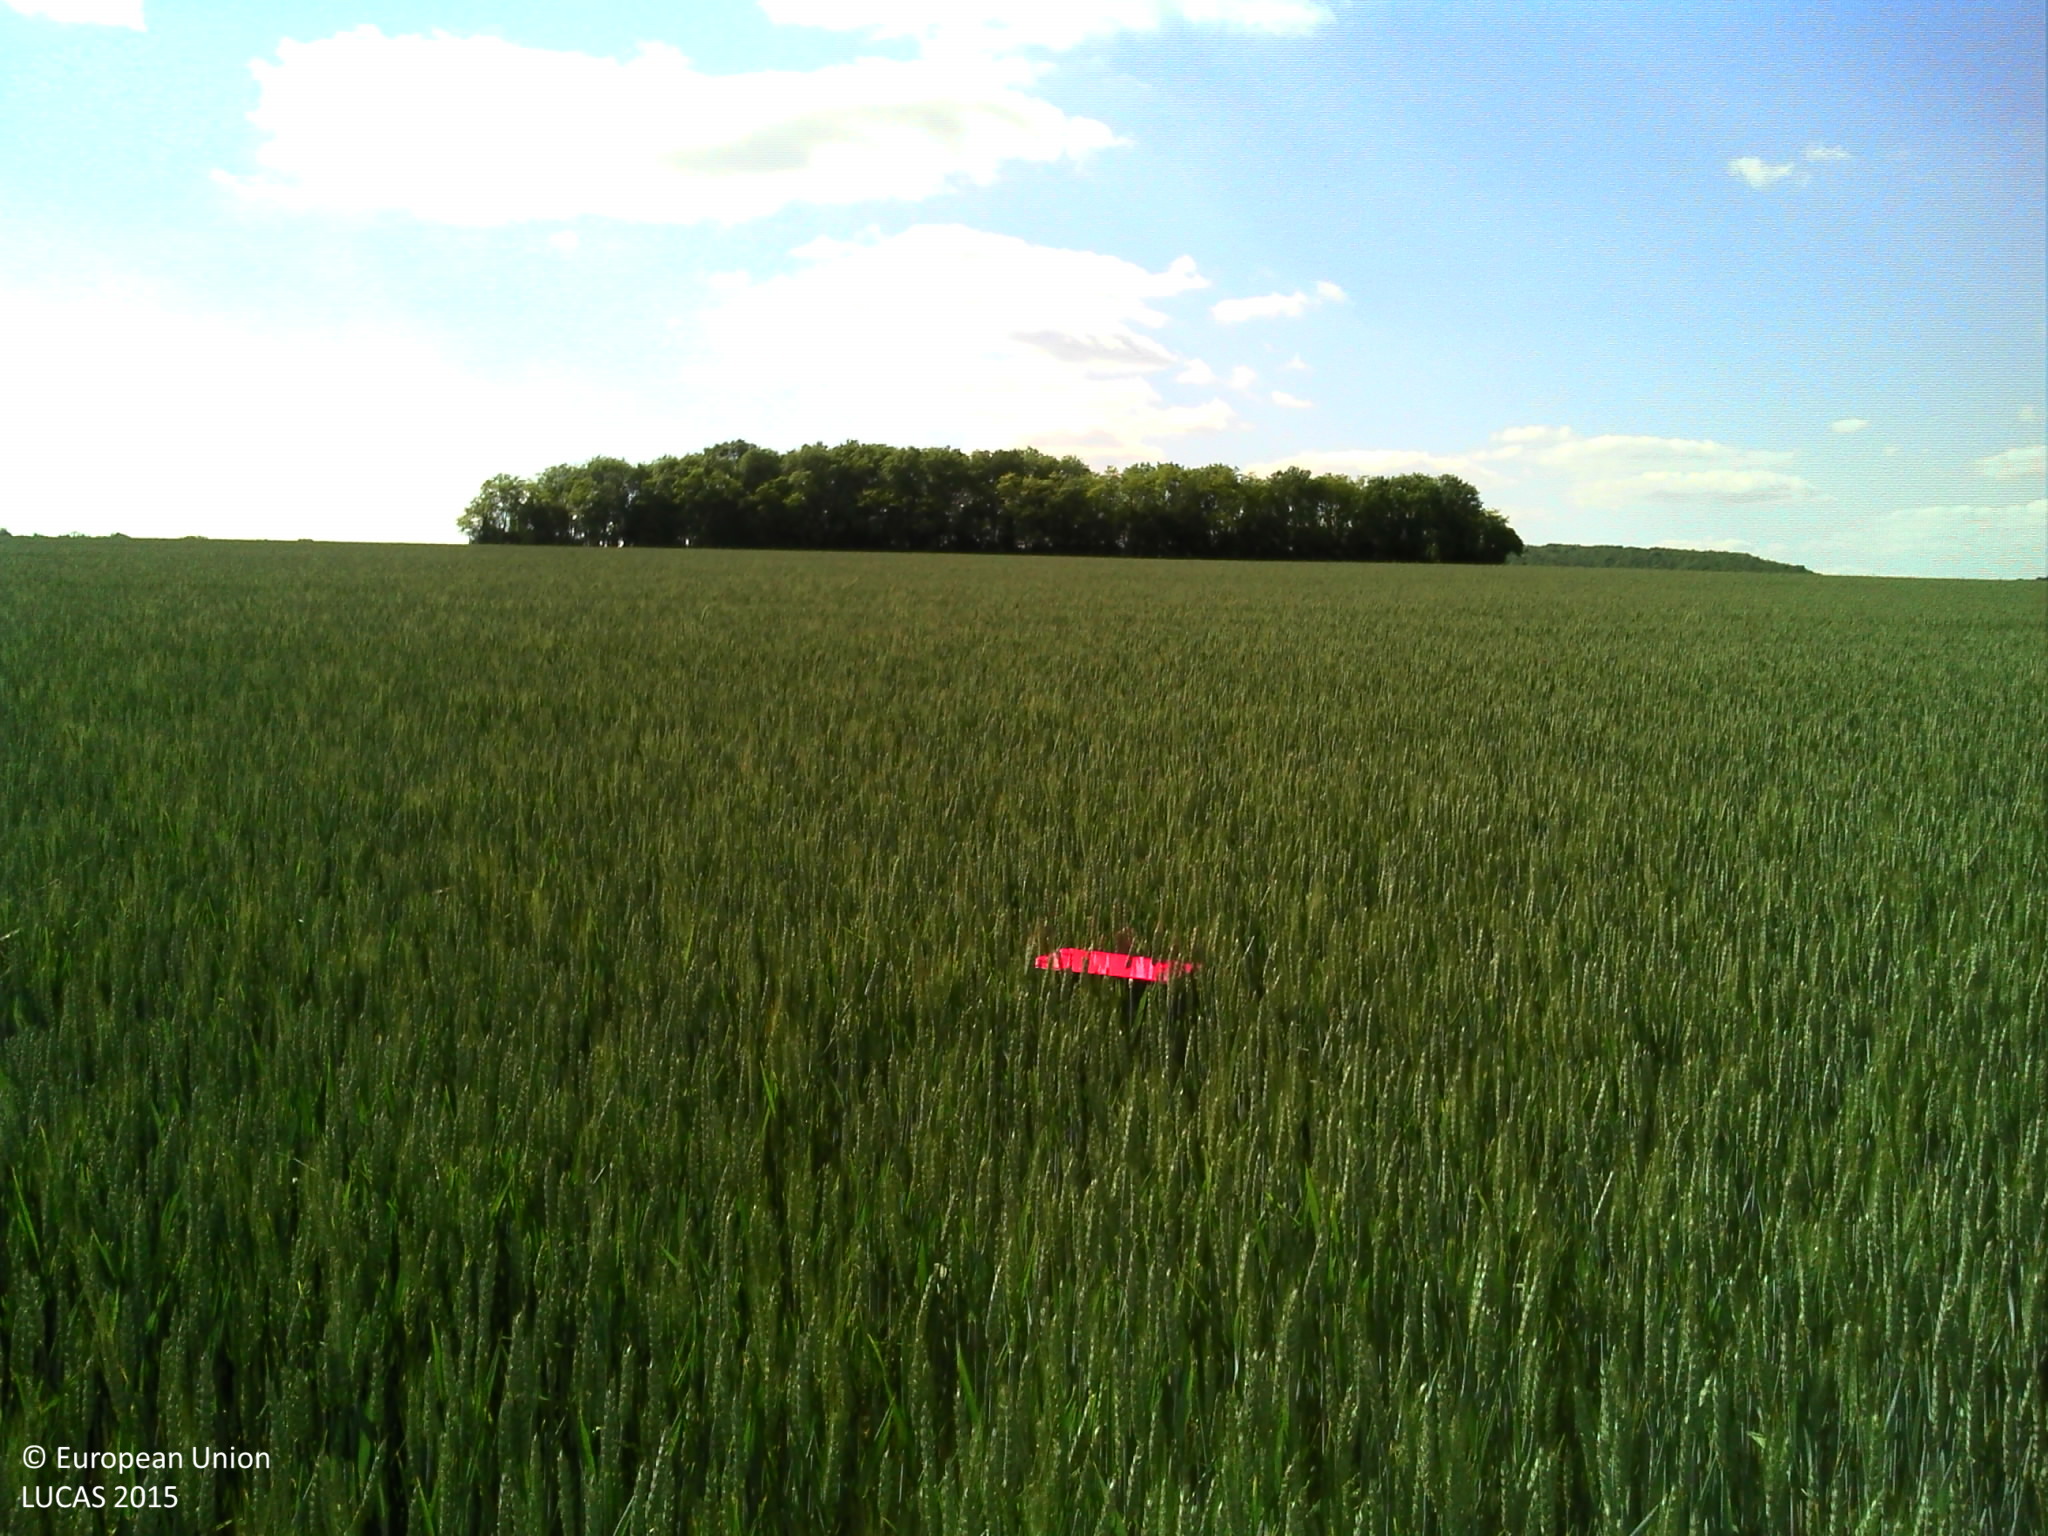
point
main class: Cropland
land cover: Common wheat
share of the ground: > 75 %
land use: Agriculture (excluding fallow land and kitchen gardens)
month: May
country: FR
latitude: 47.3879
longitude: 4.9796
